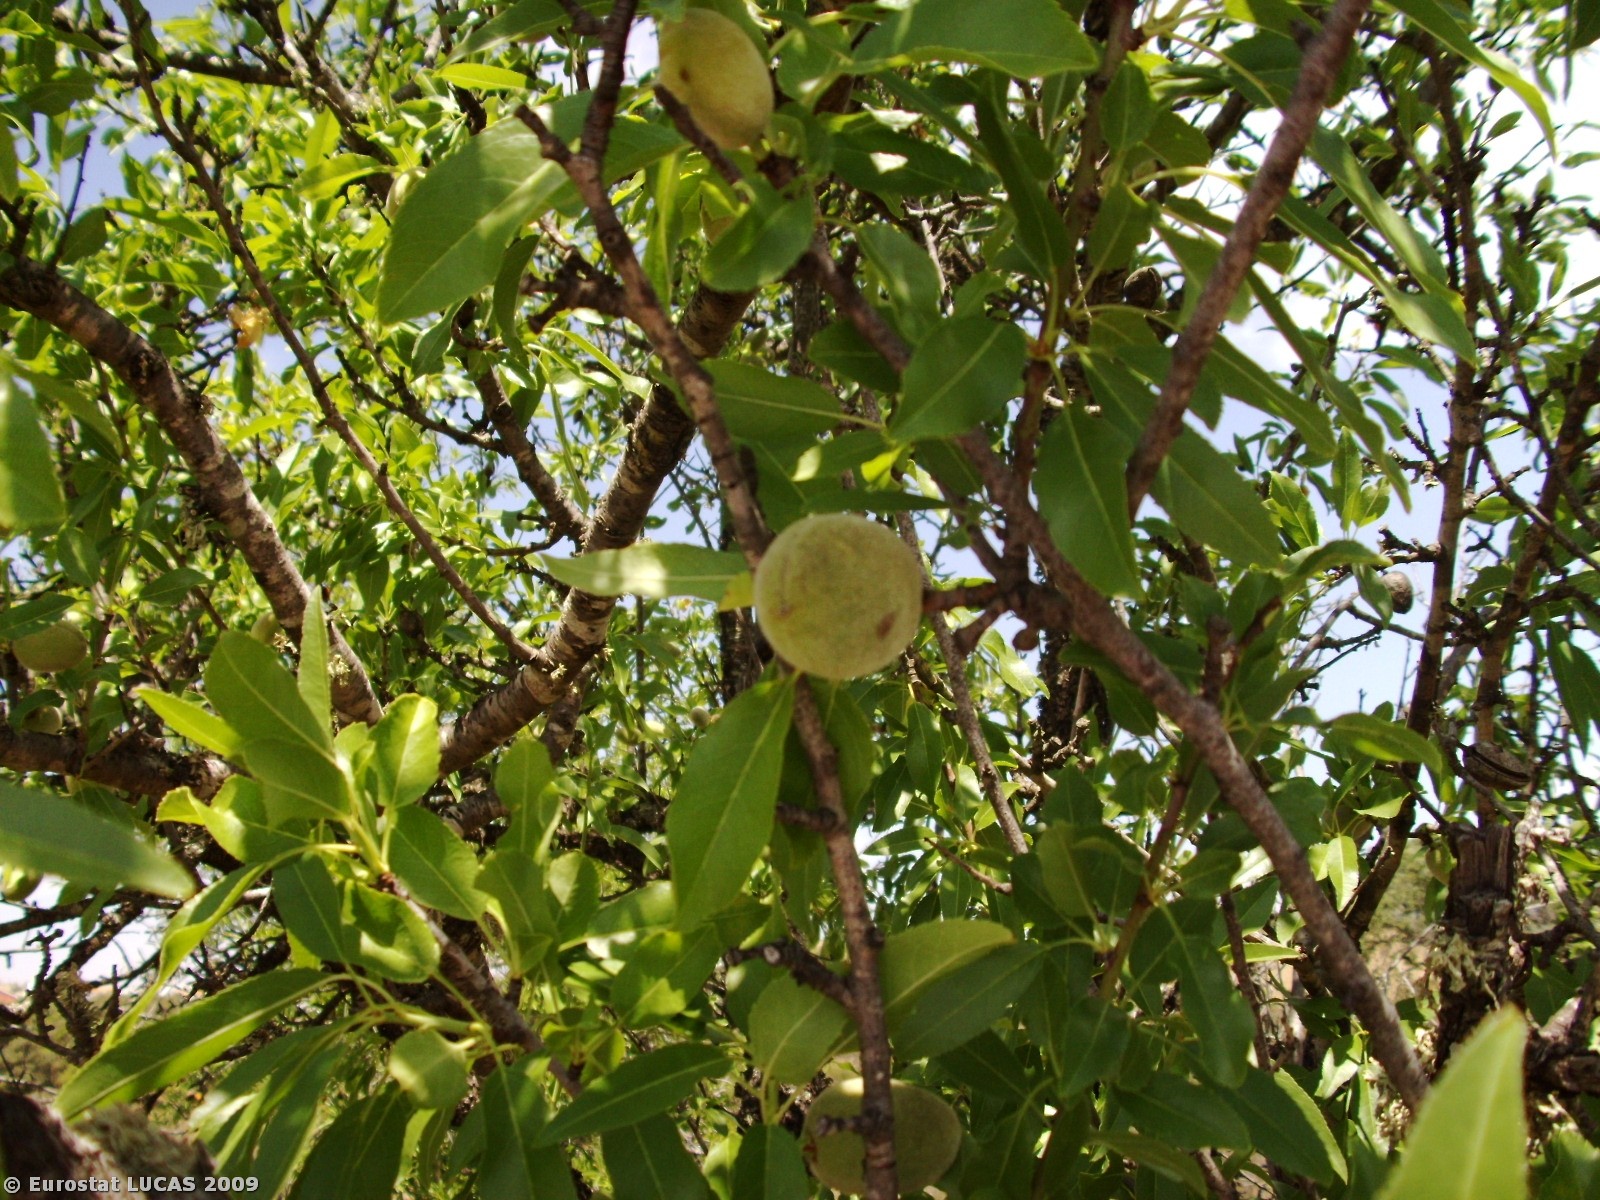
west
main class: Cropland
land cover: Nuts trees
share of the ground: < 10 %
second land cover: Spontaneously vegetated surfaces
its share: > 75 %
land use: Agriculture (excluding fallow land and kitchen gardens)
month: May
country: PT
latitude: 37.4200
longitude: -7.7186
